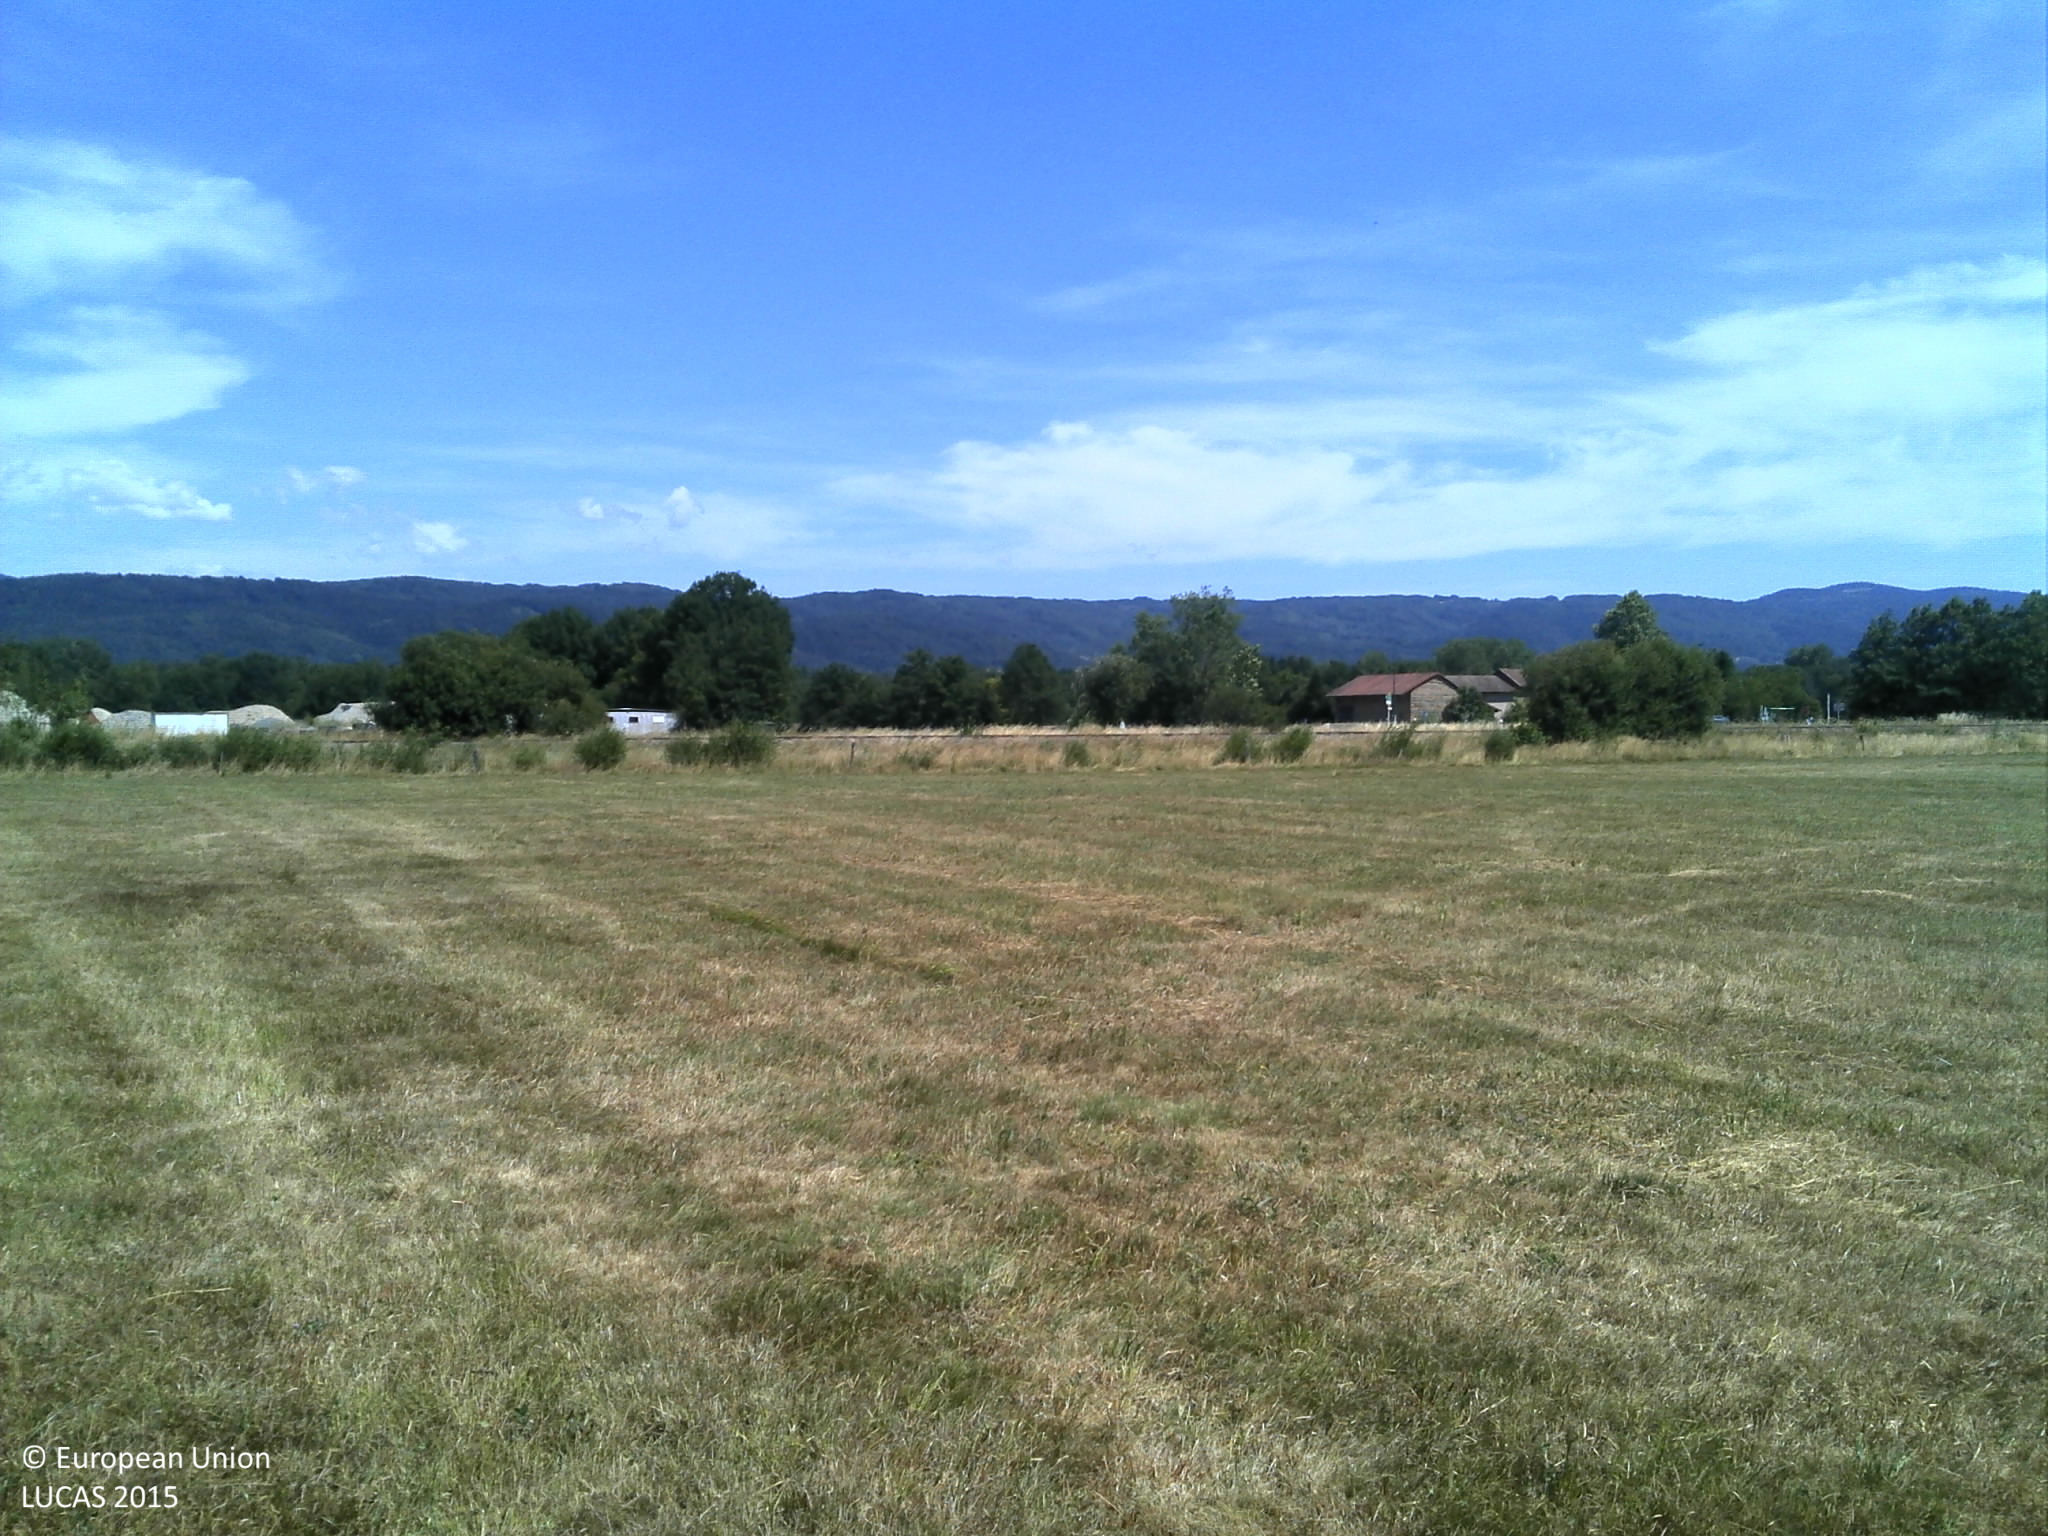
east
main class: Grassland
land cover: Grassland without tree/shrub cover
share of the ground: > 75 %
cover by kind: herbaceous plants 100 %
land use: Agriculture (excluding fallow land and kitchen gardens)
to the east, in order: Grassland without tree/shrub cover; Abandoned hedges; Fences; Grass margins; Ditches and canals; Grass margins; Railways; Grass margins; Spontaneously vegetated surfaces; Paved roads, cycling and walking lanes; Grass margins; Electric lines; Artificial constructions in urban areas
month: July
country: FR
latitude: 45.4622
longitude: 3.7230
